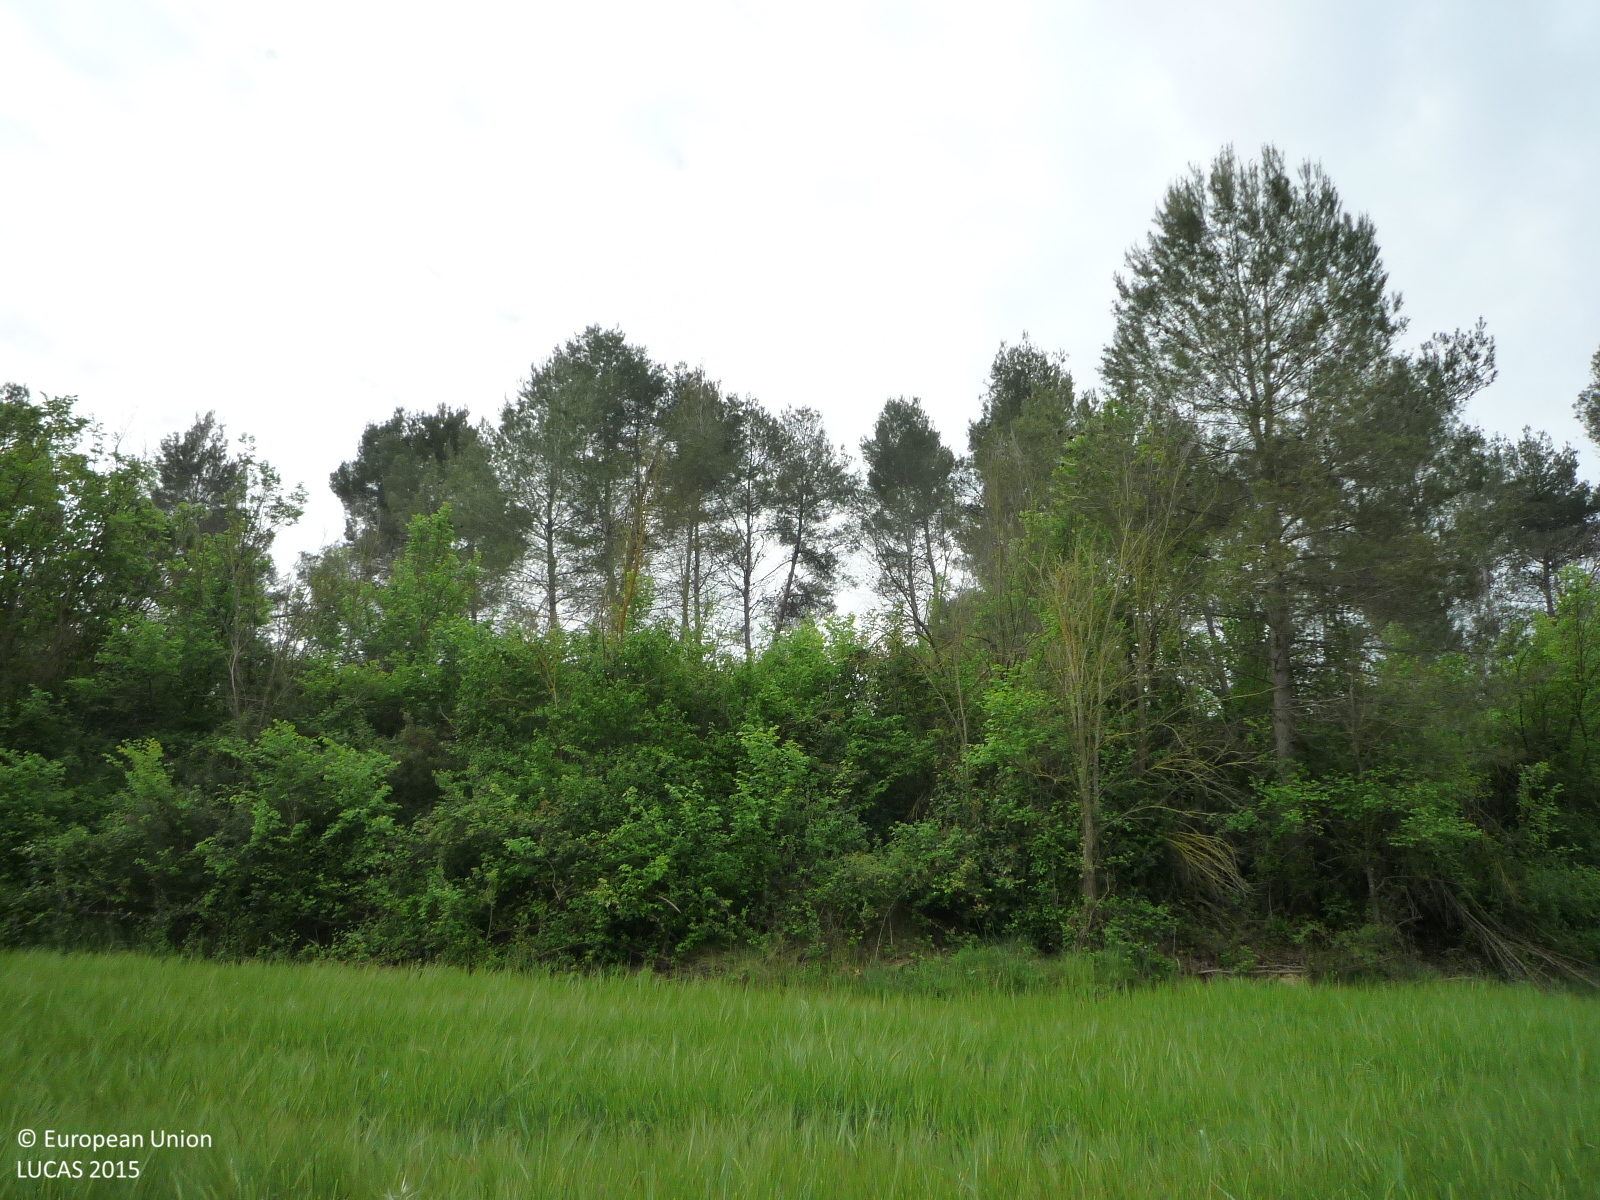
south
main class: Cropland
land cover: Barley
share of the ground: > 75 %
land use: Agriculture (excluding fallow land and kitchen gardens)
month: April
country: ES
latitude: 41.6190
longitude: 1.6504
